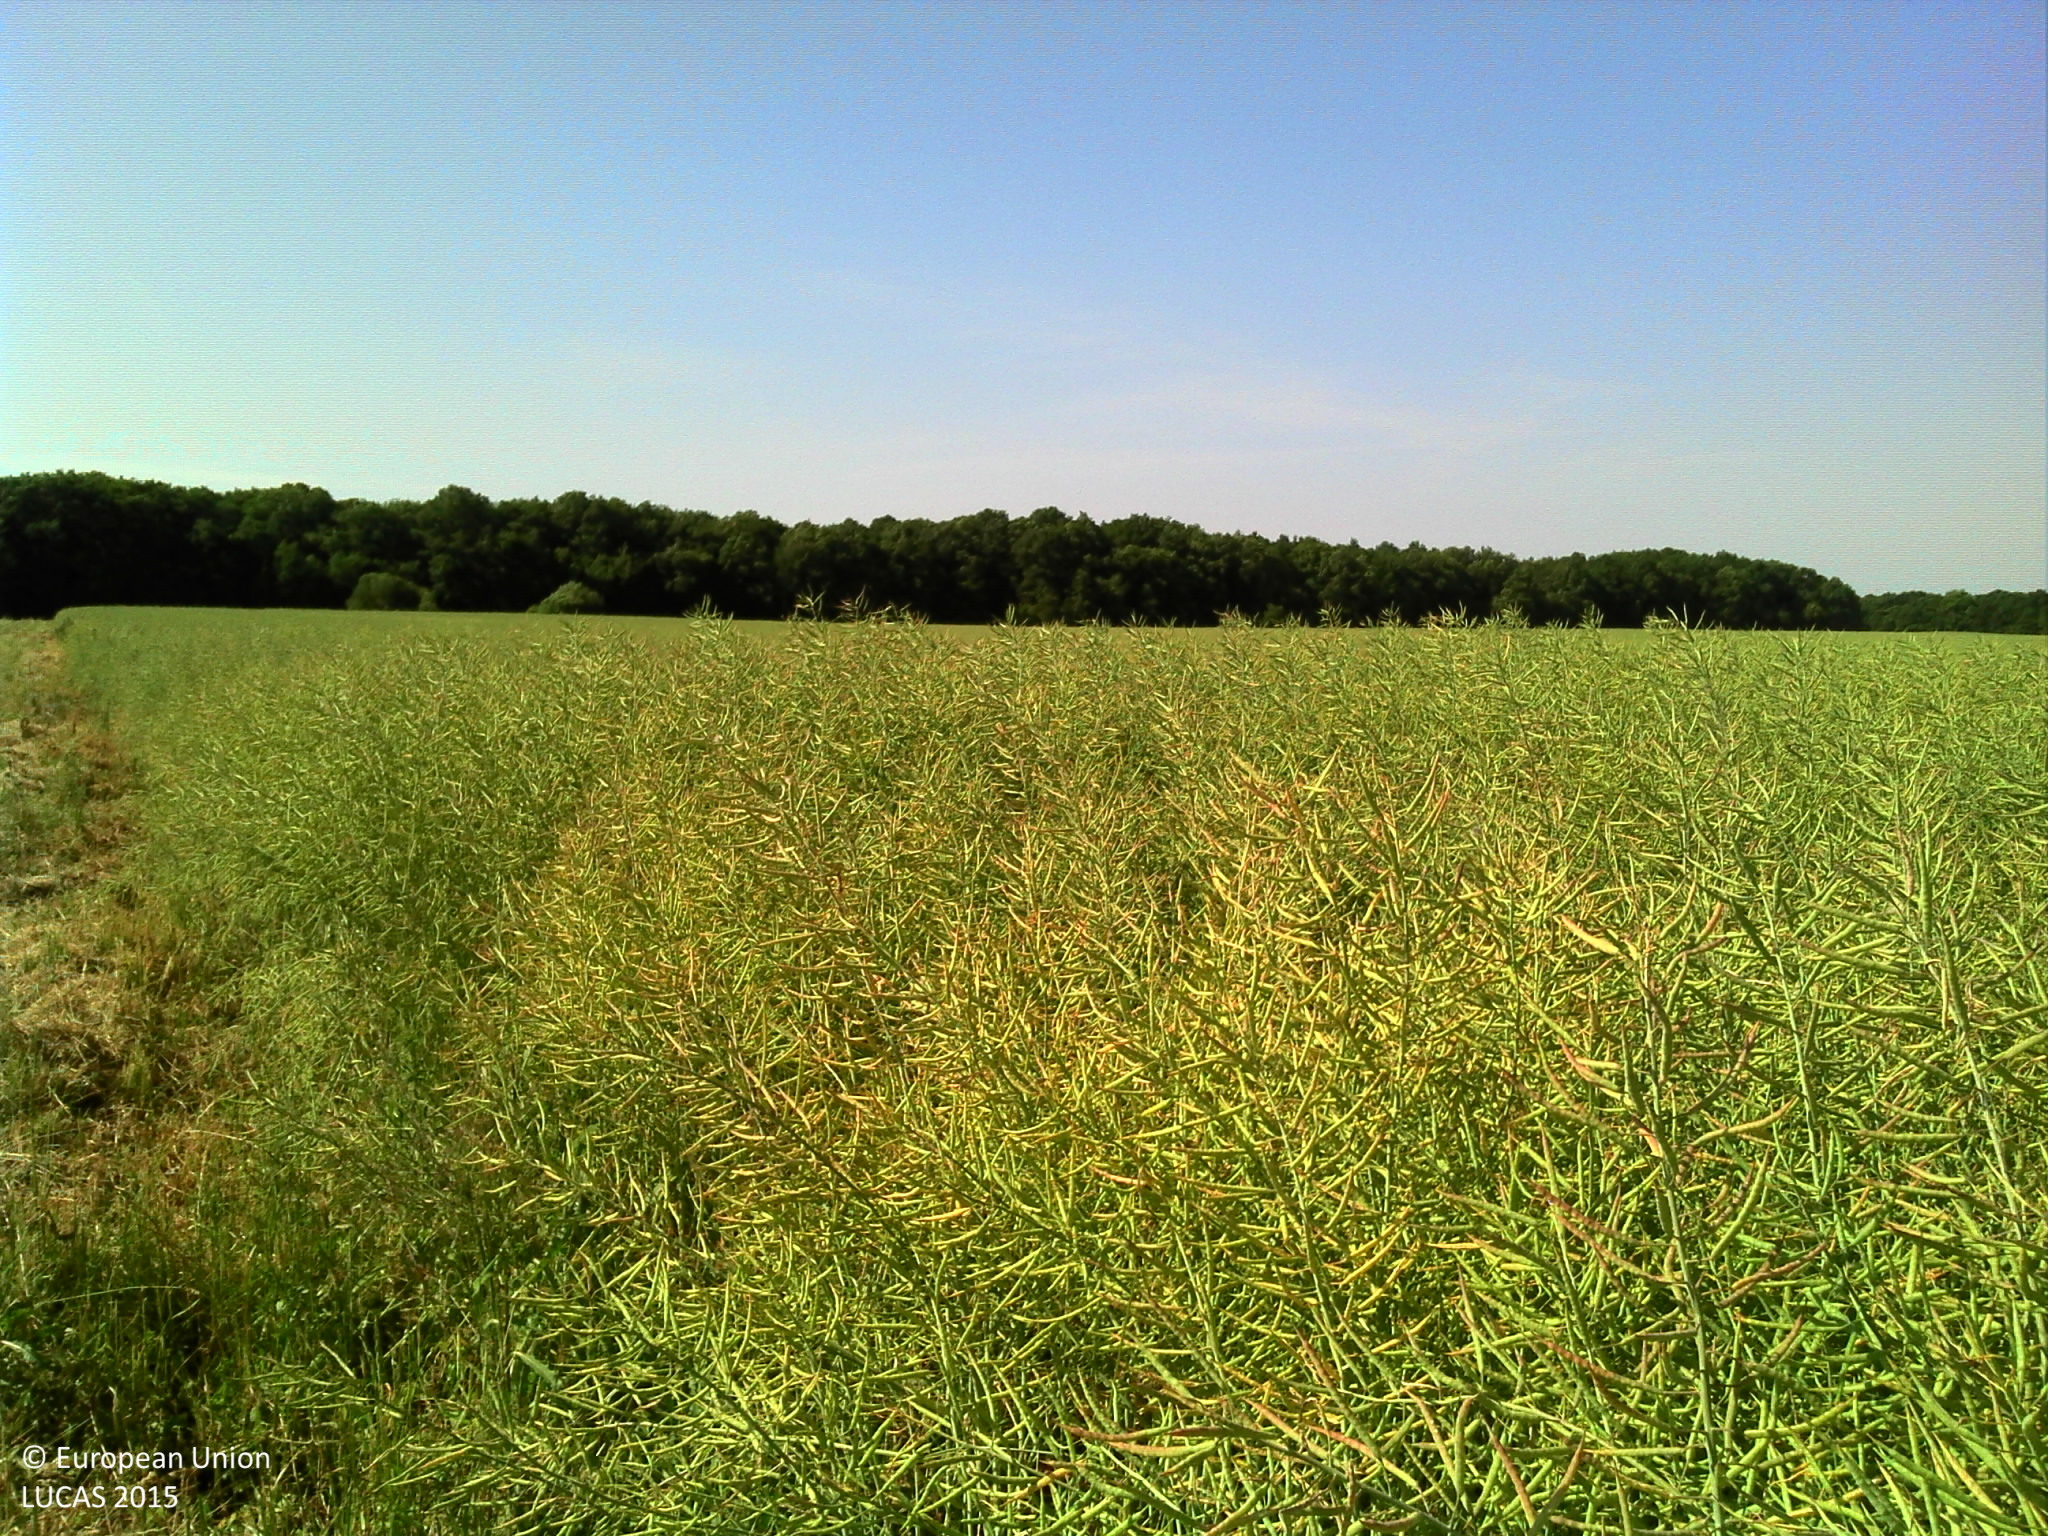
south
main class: Cropland
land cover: Rape and turnip rape
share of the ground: > 75 %
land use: Agriculture (excluding fallow land and kitchen gardens)
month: June
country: FR
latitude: 47.1108
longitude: 2.6535
